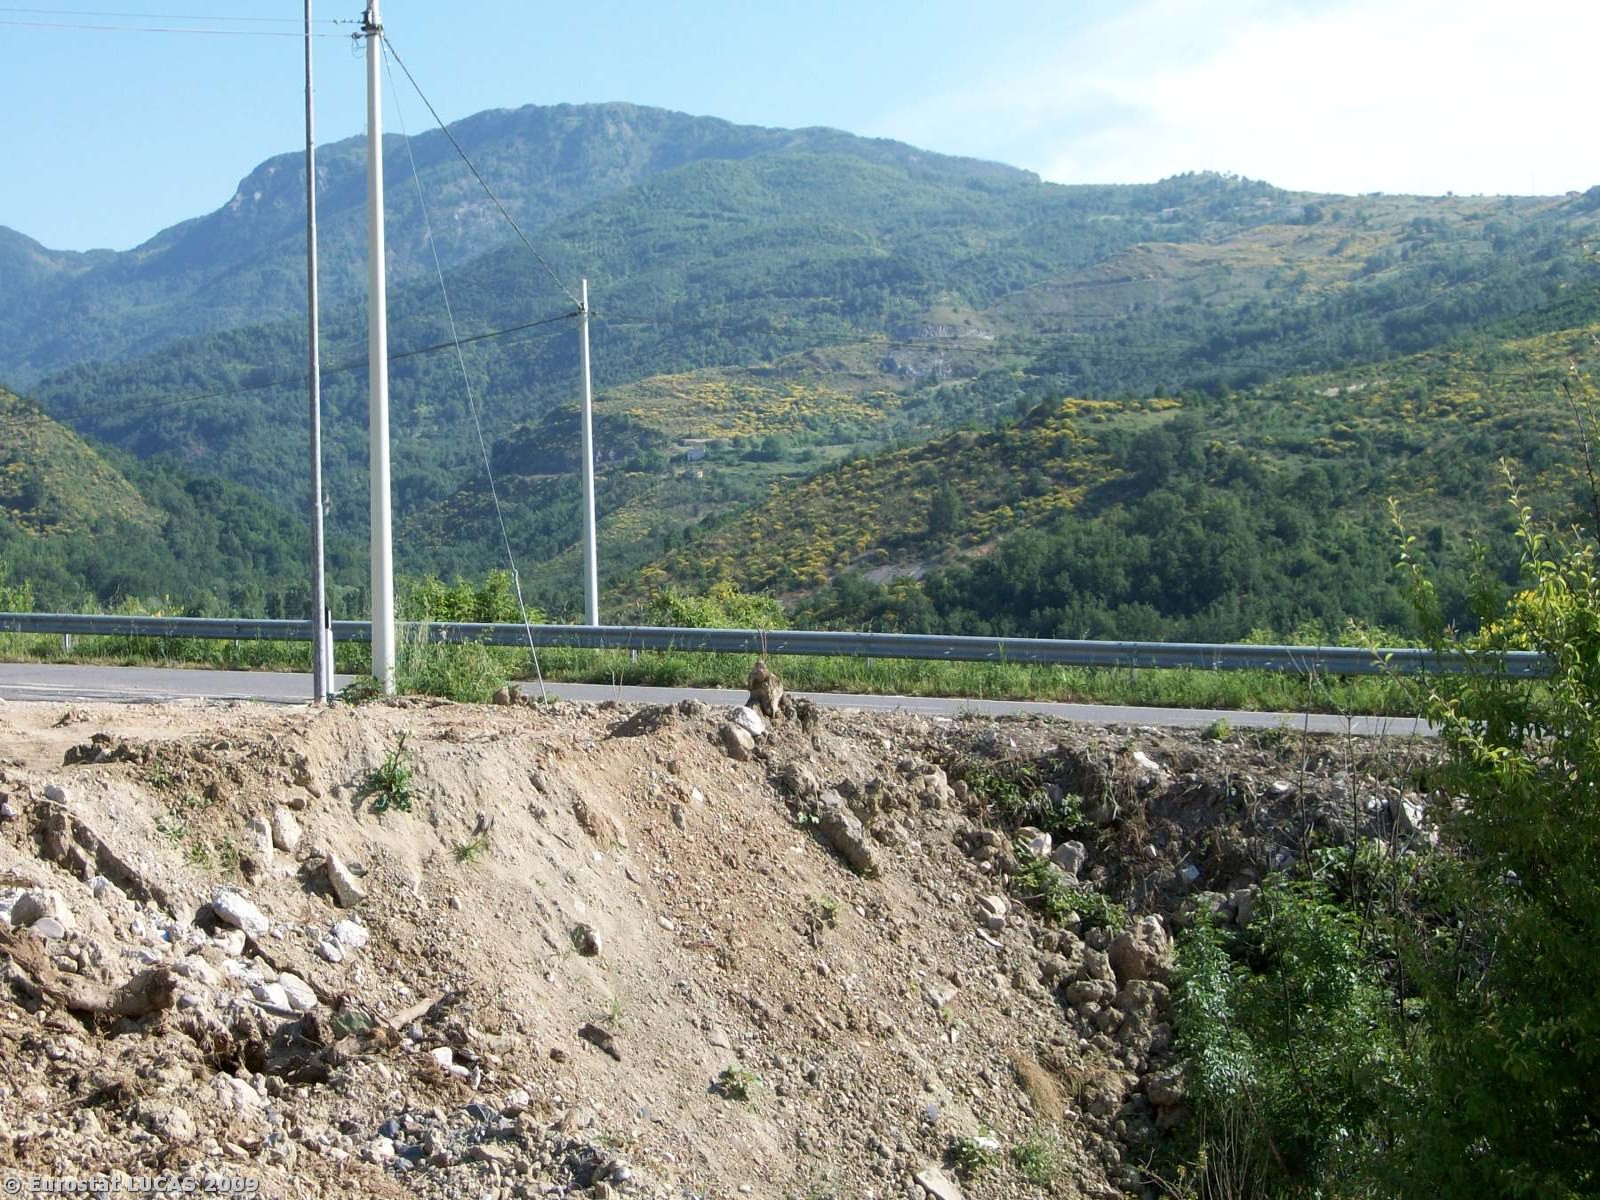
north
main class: Shrubland
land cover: Shrubland without tree cover
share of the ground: > 75 %
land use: Unused
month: June
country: IT
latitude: 39.6980
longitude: 16.0714
